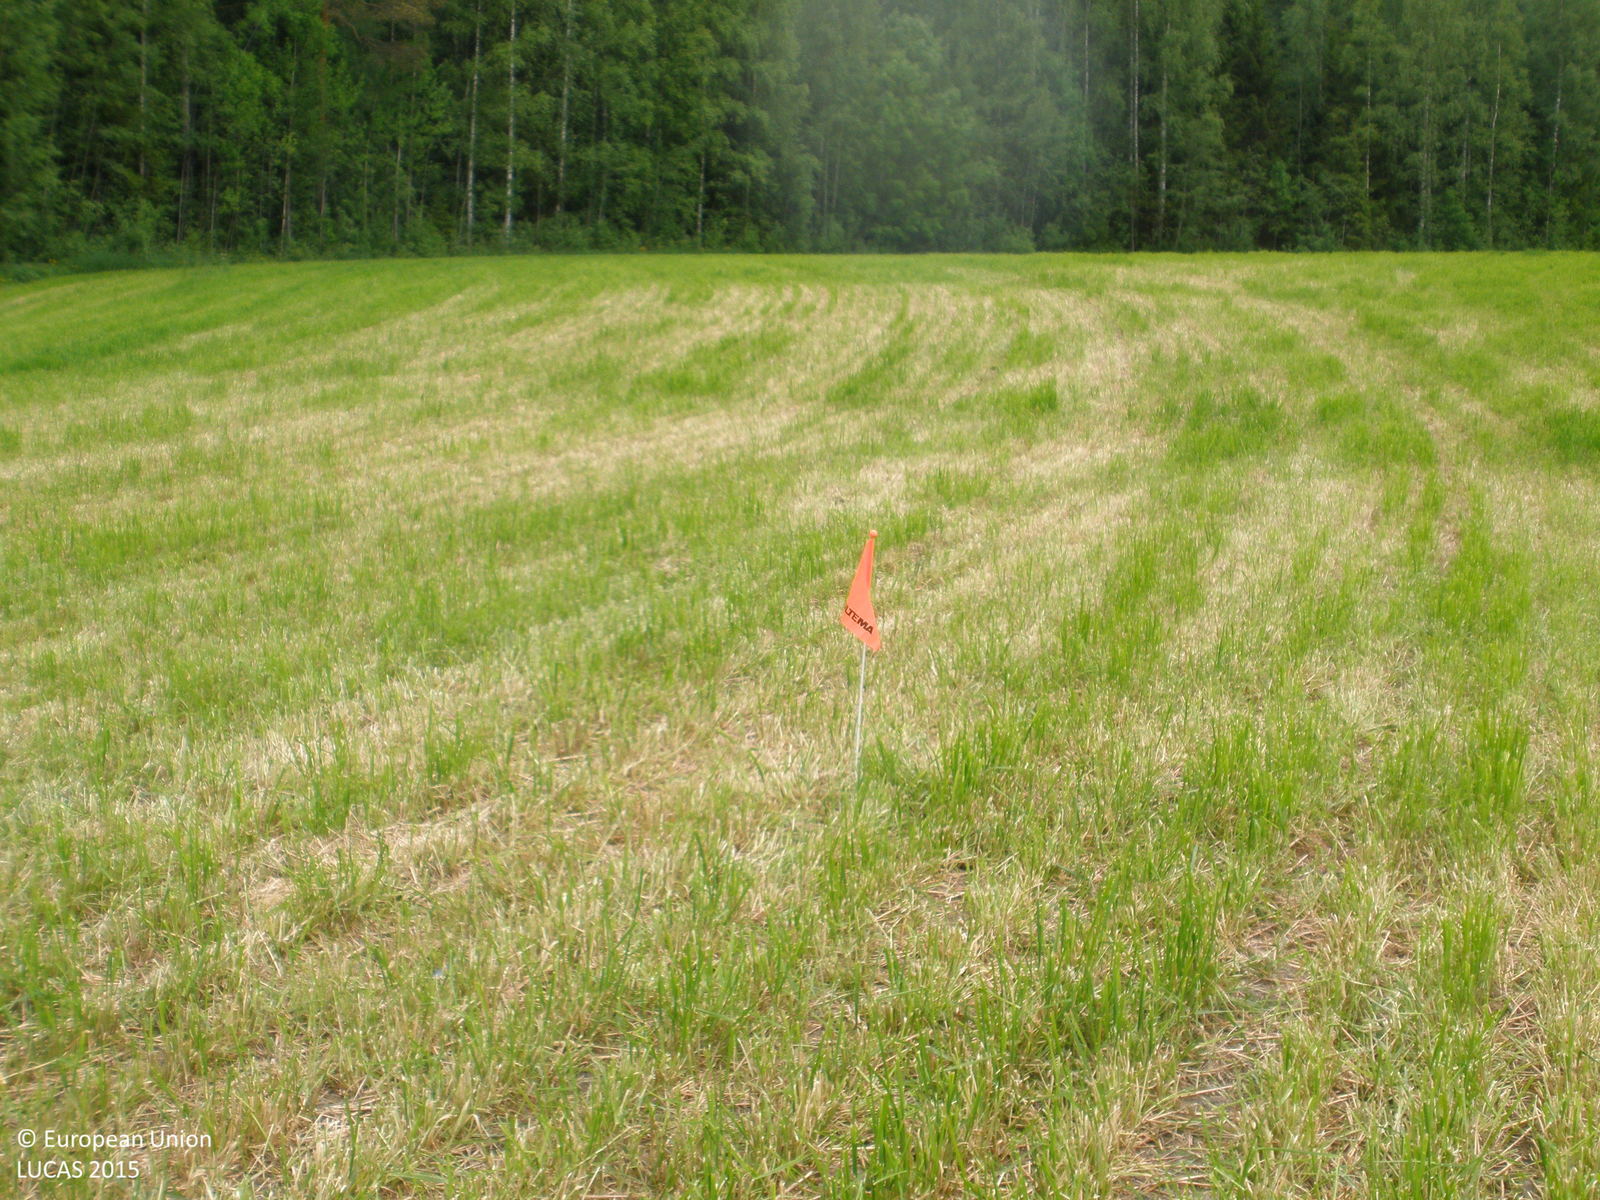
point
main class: Cropland
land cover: Temporary grasslands
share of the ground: 25 - 50 %
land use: Agriculture (excluding fallow land and kitchen gardens)
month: June
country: FI
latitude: 61.2605
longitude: 24.5123
